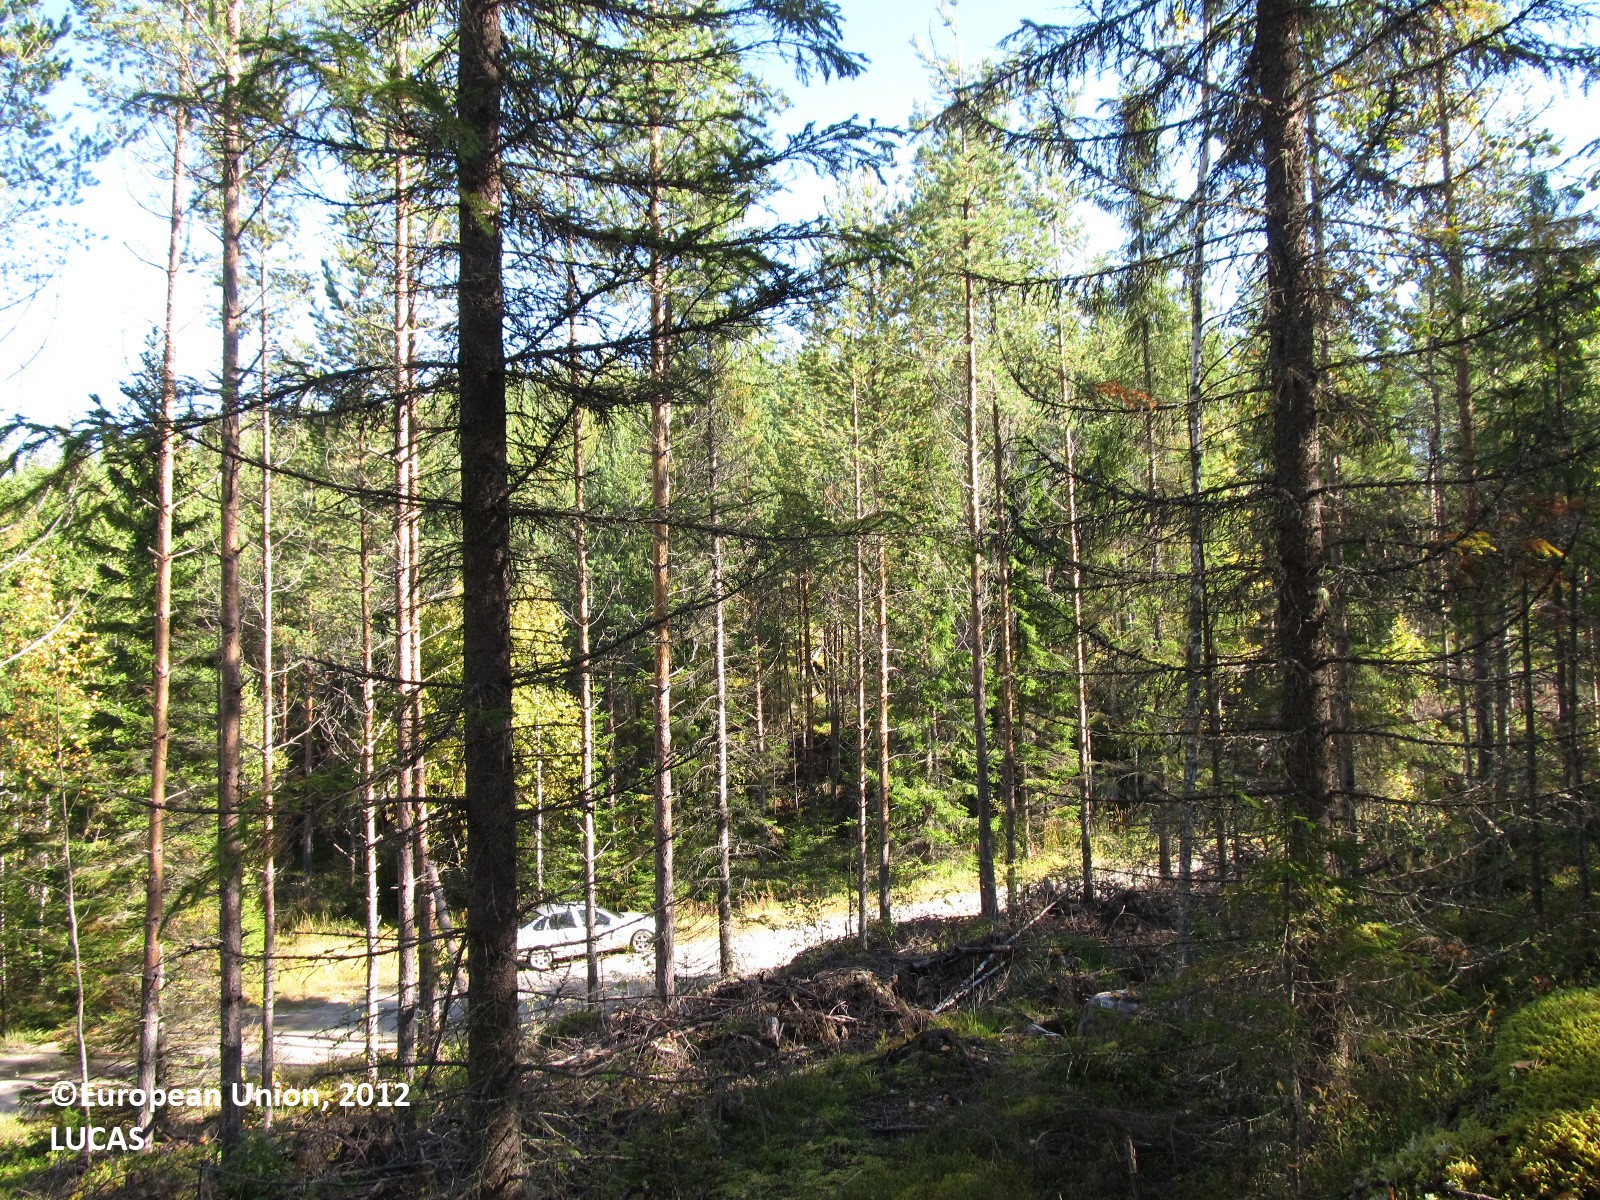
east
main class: Woodland
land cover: Other coniferous woodland
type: boreal forest
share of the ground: 50 - 75 %
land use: Forestry
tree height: > 5 m
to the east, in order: Other coniferous woodland; Ditches and canals; Paved roads, cycling and walking lanes; Ditches and canals; Pine dominated coniferous woodland; Pine dominated mixed woodland
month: September
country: FI
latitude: 62.4478
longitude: 28.5554
